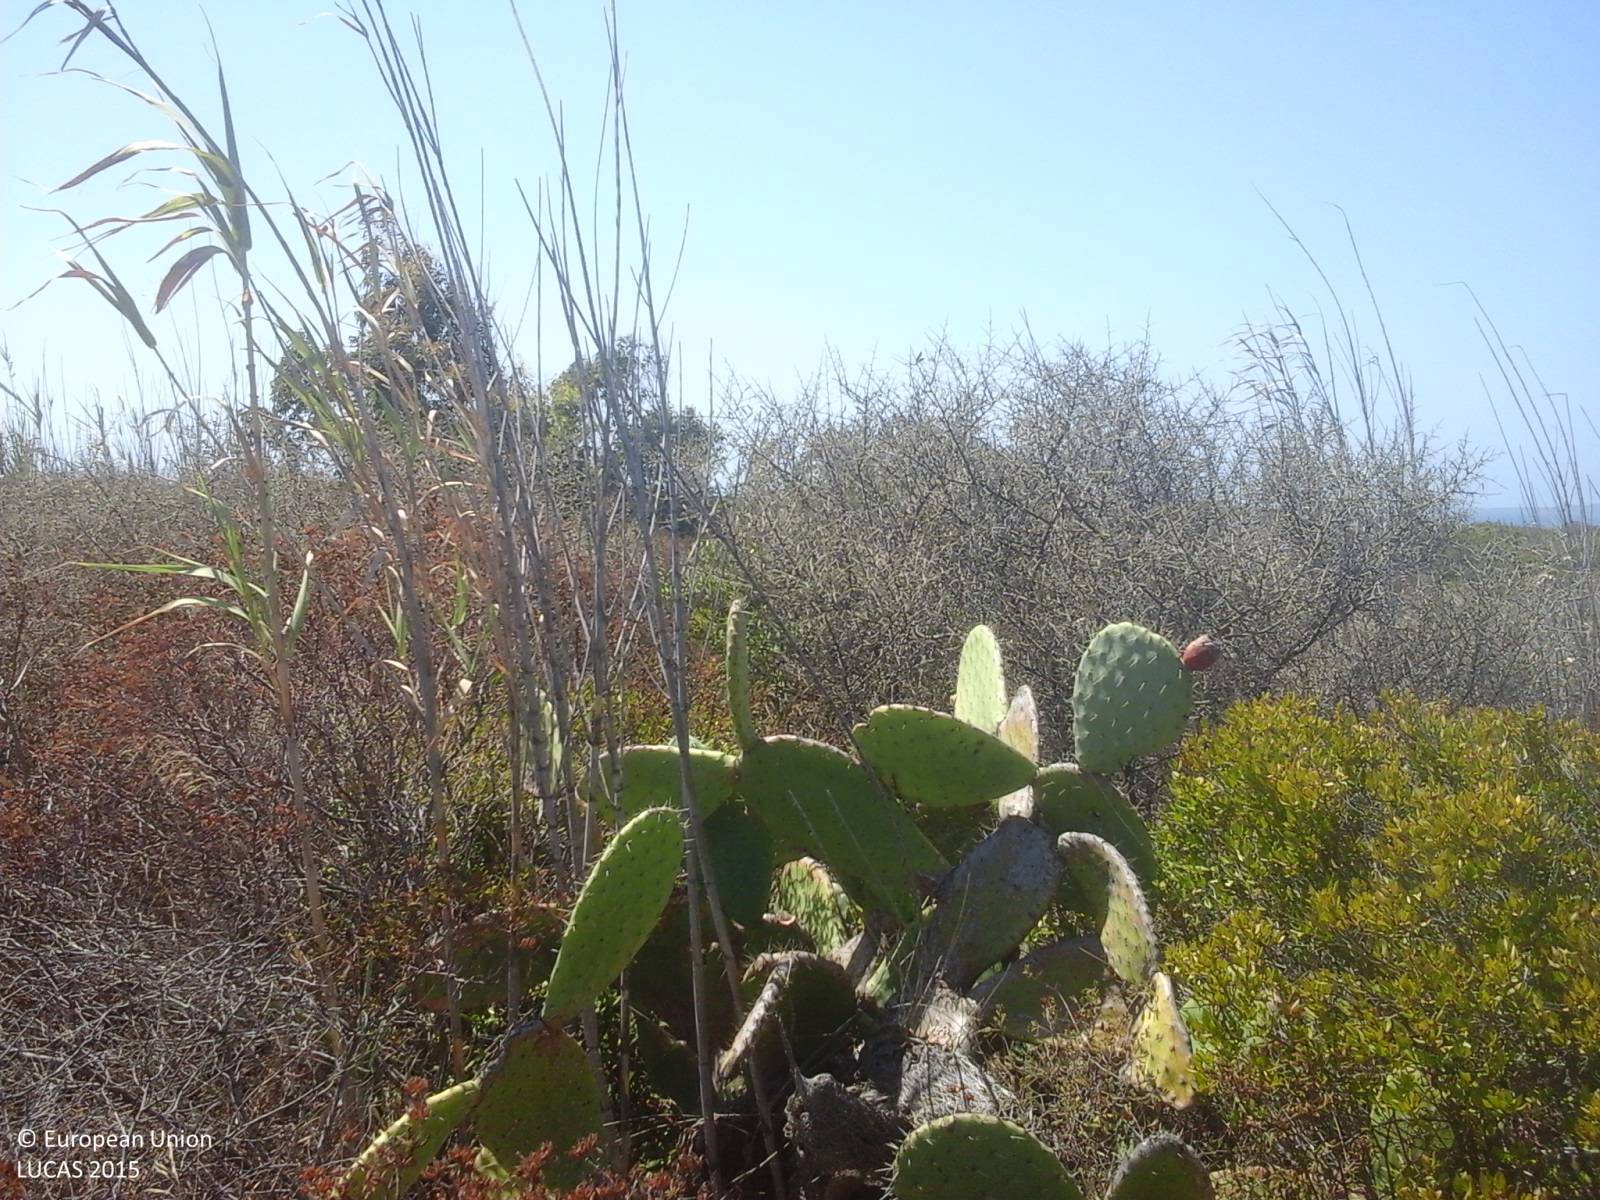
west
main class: Shrubland
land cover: Shrubland without tree cover
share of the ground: > 75 %
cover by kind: shrubs 60 %, herbaceous plants 20 %, unconsolidated bare surface 20 %
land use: Semi-natural and natural areas not in use
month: July
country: IT
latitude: 39.2040
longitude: 8.4233
